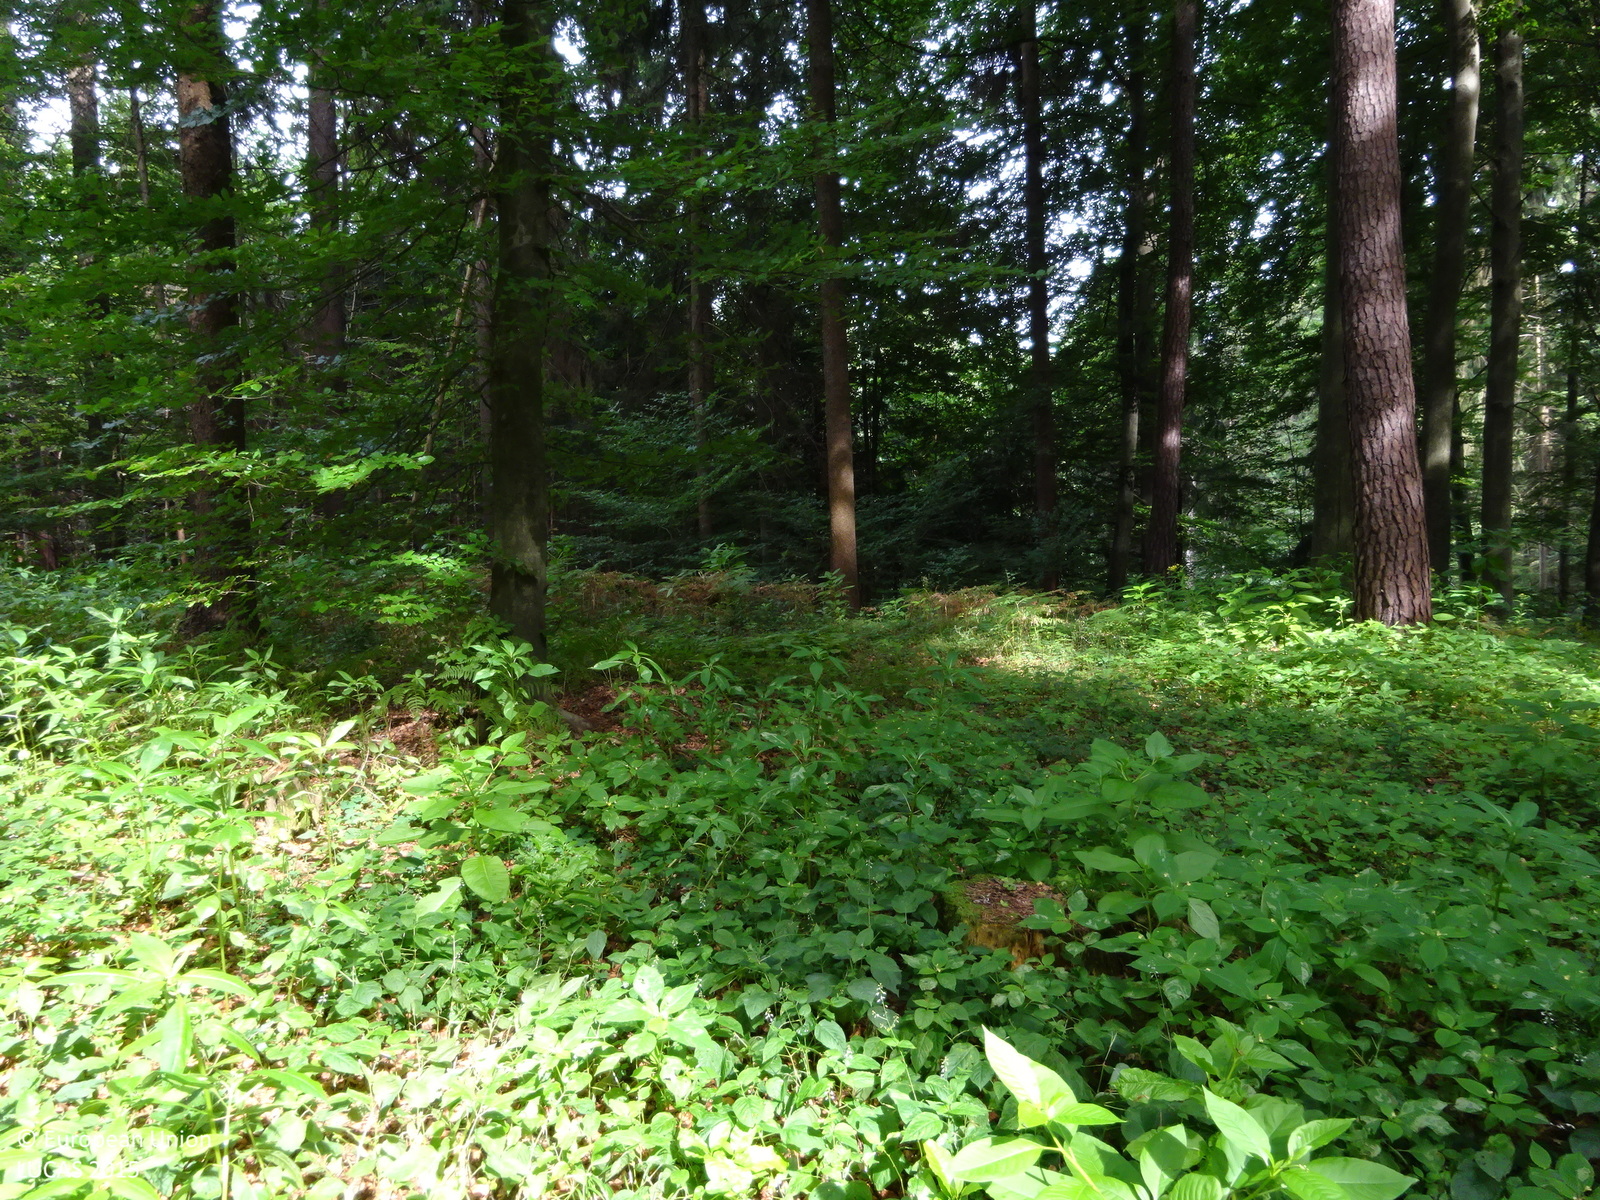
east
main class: Woodland
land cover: Other mixed woodland
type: hemiboreal forest and nemoral coniferous forest and mixed broadleaved-coniferous forest
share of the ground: > 75 %
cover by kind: broadleaved forest trees 65 %, coniferous forest trees 25 %, herbaceous plants 10 %
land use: Forestry
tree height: > 5 m
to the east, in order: Other mixed woodland; Spruce dominated mixed woodland; Spruce dominated coniferous woodland; Tracks; Spruce dominated coniferous woodland; Tracks; Spruce dominated mixed woodland; Paved roads, cycling and walking lanes; Spruce dominated mixed woodland
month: July
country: AT
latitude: 46.9009
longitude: 15.3946
